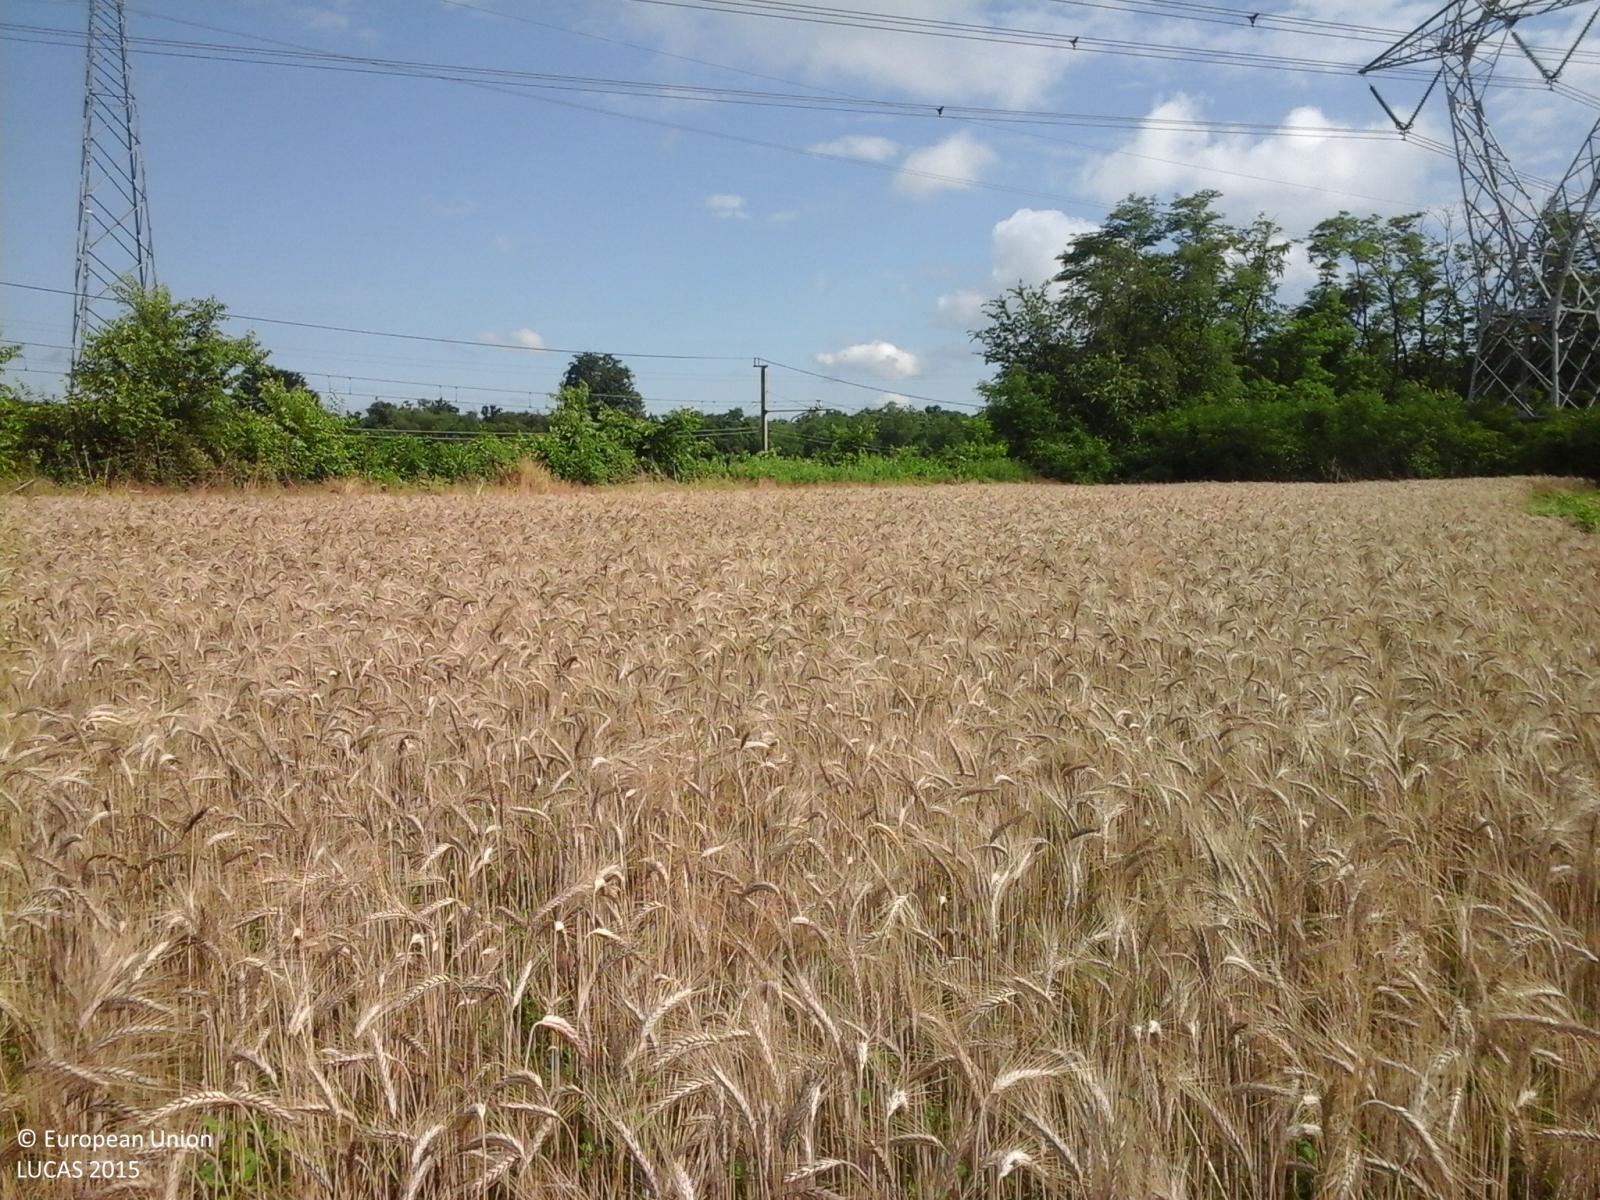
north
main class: Cropland
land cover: Triticale
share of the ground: > 75 %
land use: Agriculture (excluding fallow land and kitchen gardens)
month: June
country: IT
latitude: 45.4965
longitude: 8.7097
